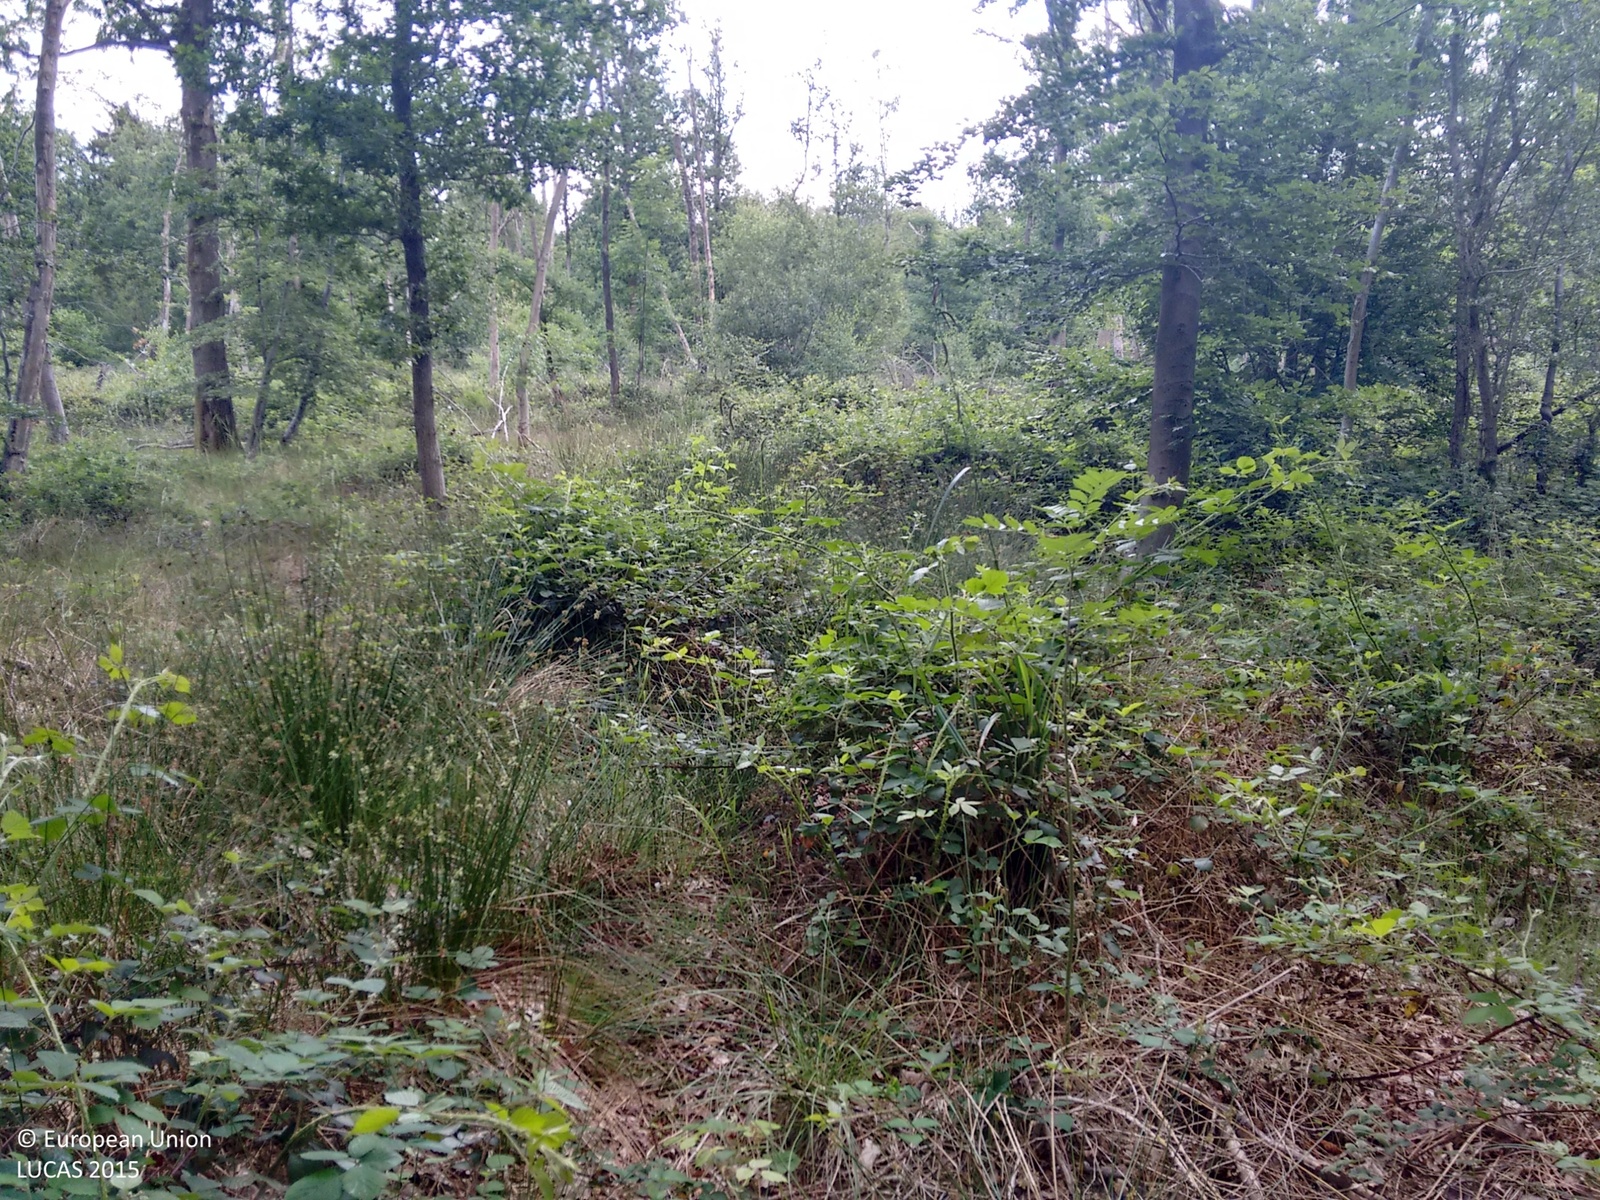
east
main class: Woodland
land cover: Broadleaved woodland
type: mesophytic deciduous forest
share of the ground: > 75 %
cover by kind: broadleaved forest trees 100 %
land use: Forestry
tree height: > 5 m
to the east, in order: Broadleaved woodland; Spruce dominated mixed woodland; Tracks; Spruce dominated mixed woodland
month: June
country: GB
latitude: 51.5731
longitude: -1.9322
